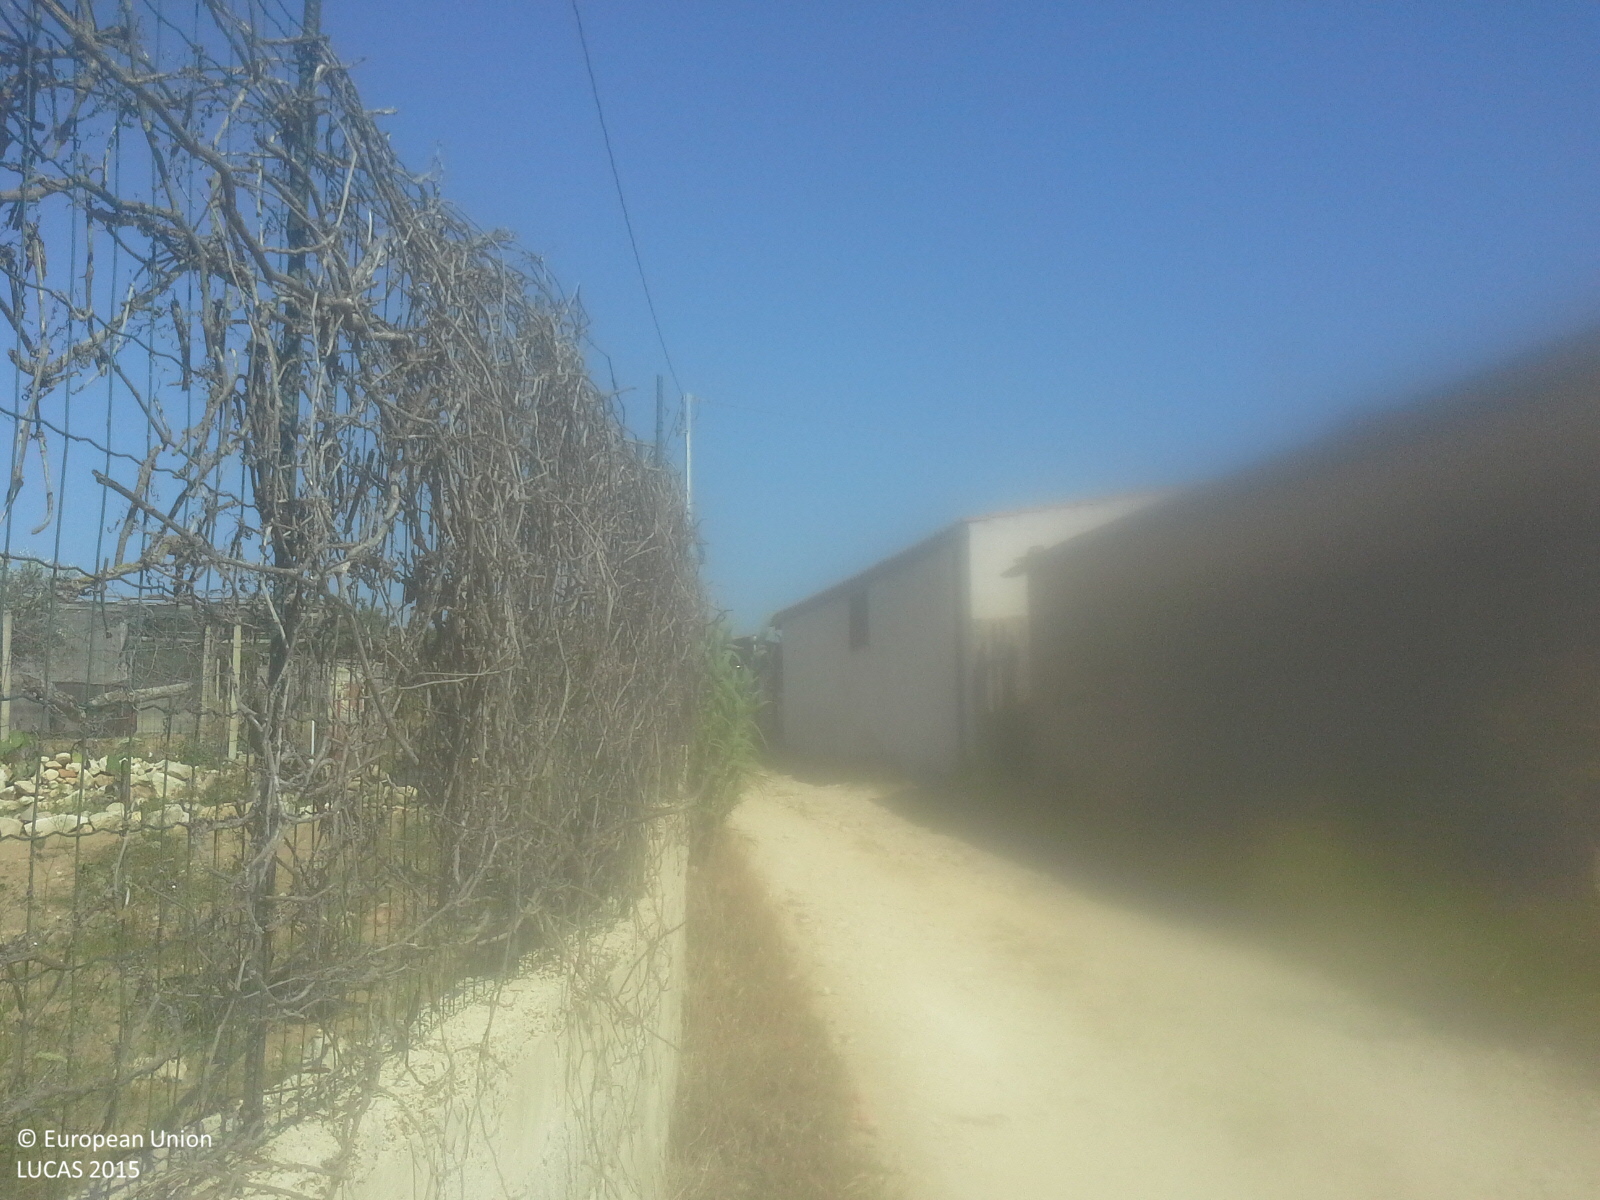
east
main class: Cropland
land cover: Olive groves
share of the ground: > 75 %
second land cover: Spontaneously vegetated surfaces
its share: > 75 %
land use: Agriculture (excluding fallow land and kitchen gardens)
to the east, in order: Olive groves; Spontaneously vegetated surfaces; Lines of trees; Rocks and stones; Fences; Tracks; Fences; Lines of trees; Artificial constructions in urban areas; Vineyards; Nuts trees; Fences; Pear fruit; Artificial constructions in urban areas; Pear fruit; Fences; Other fruit trees and berries; Fences; Vineyards; Shruby margins; Fences; Shrubland without tree cover; Fences; Vineyards
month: June
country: IT
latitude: 36.7186
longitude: 14.7641
